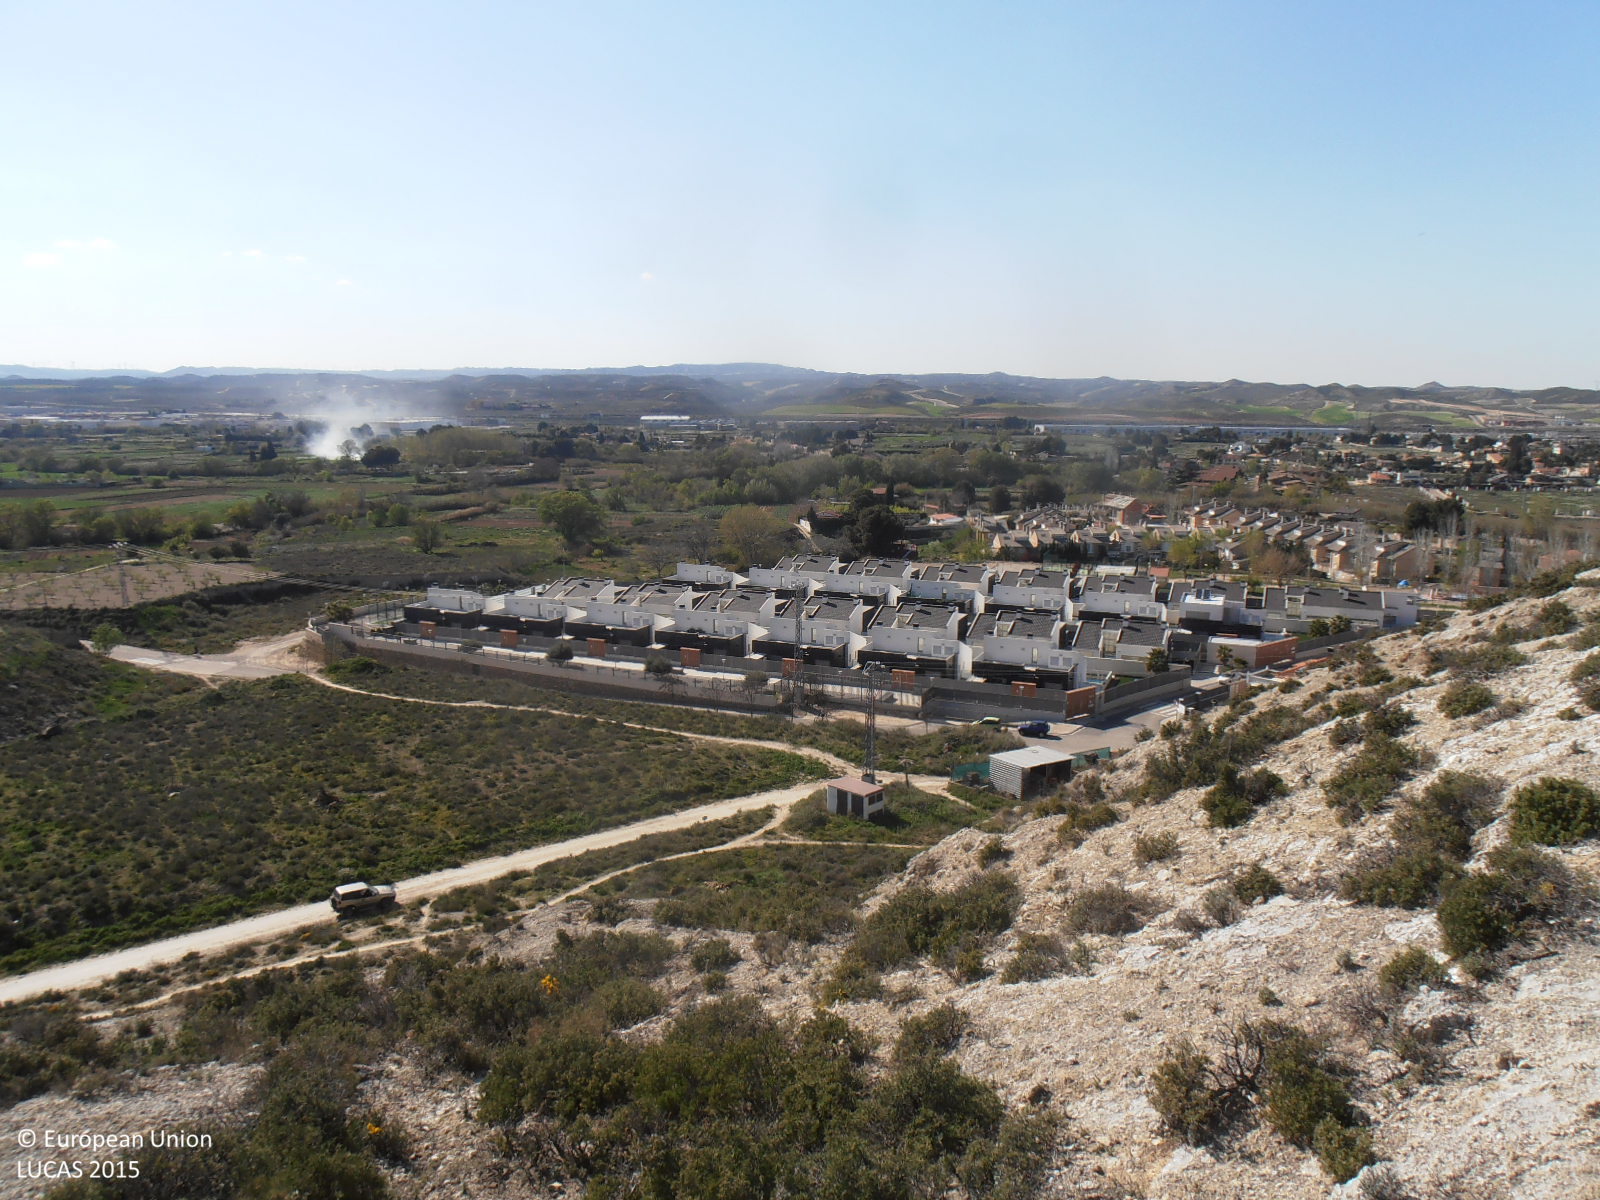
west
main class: Shrubland
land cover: Shrubland without tree cover
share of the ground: > 75 %
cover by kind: consolidated bare surface 75 %, shrubs 25 %
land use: Semi-natural and natural areas not in use
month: April
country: ES
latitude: 41.5672
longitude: -0.9461
